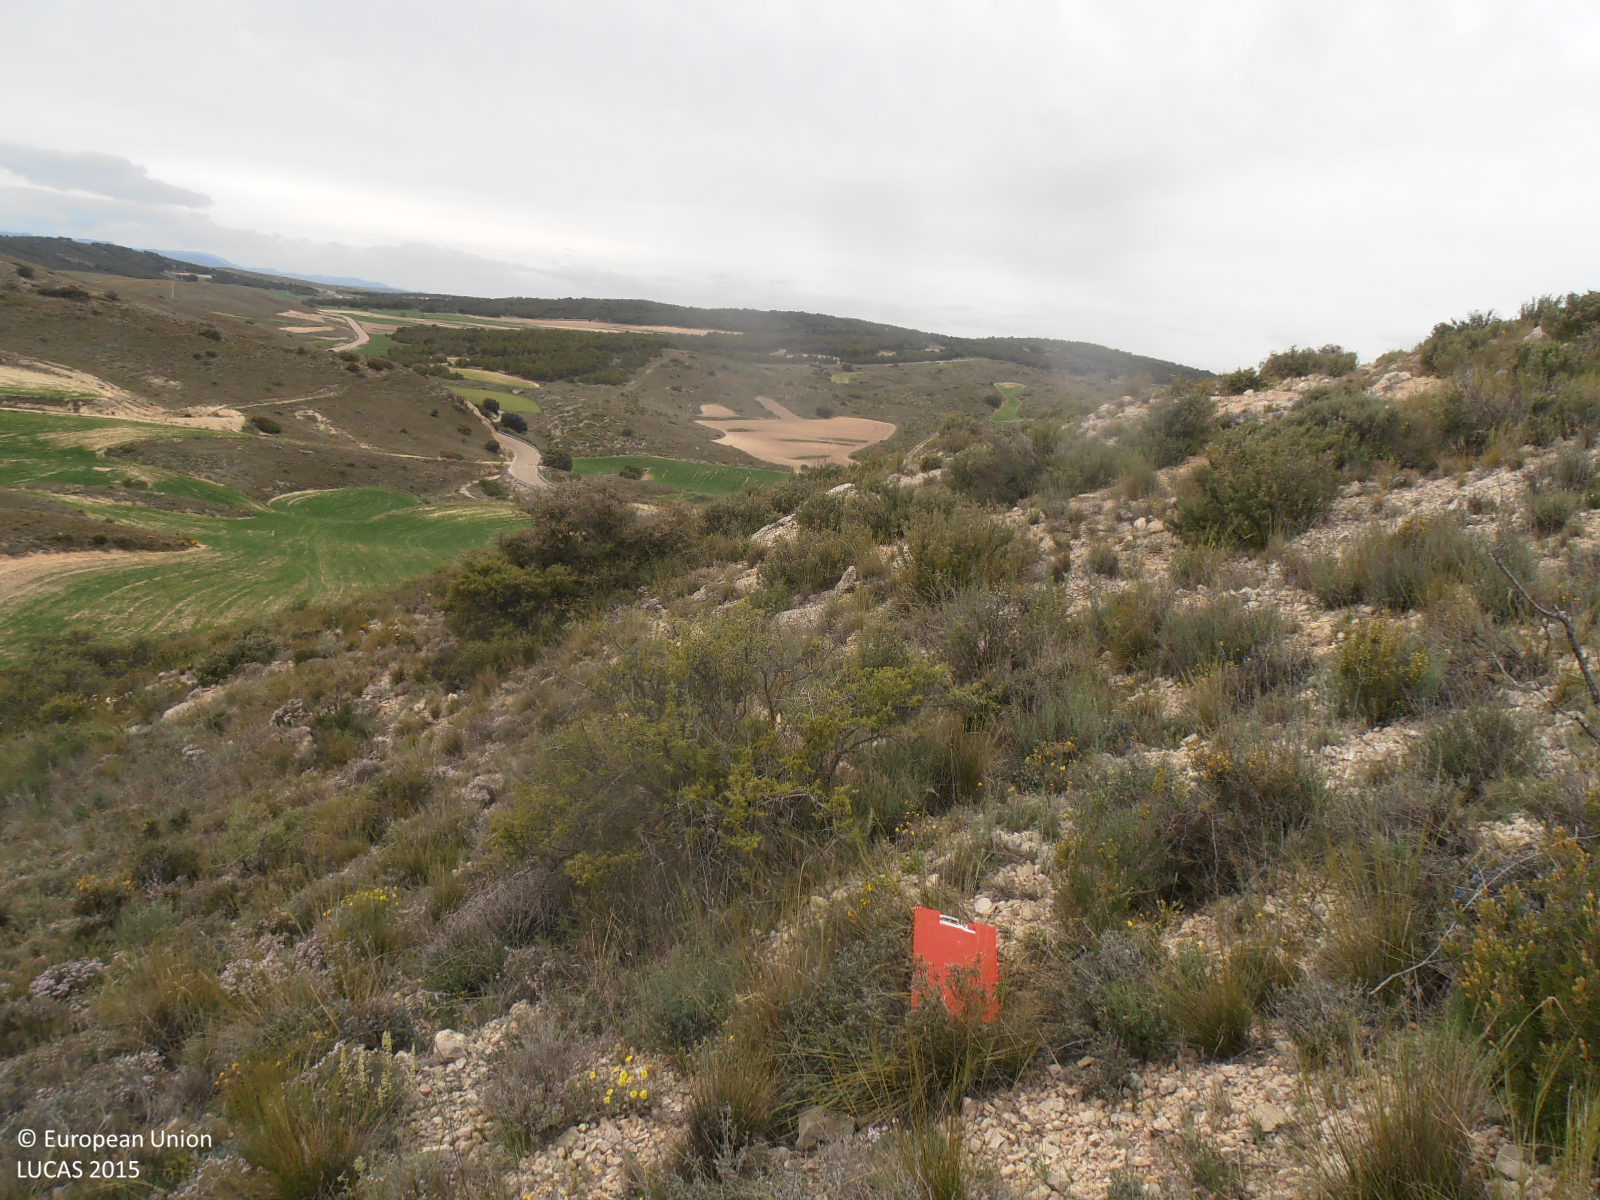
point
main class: Shrubland
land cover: Shrubland without tree cover
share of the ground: > 75 %
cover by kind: shrubs 50 %, consolidated bare surface 35 %, herbaceous plants 15 %
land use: Semi-natural and natural areas not in use
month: April
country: ES
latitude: 41.1204
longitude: -0.8669
